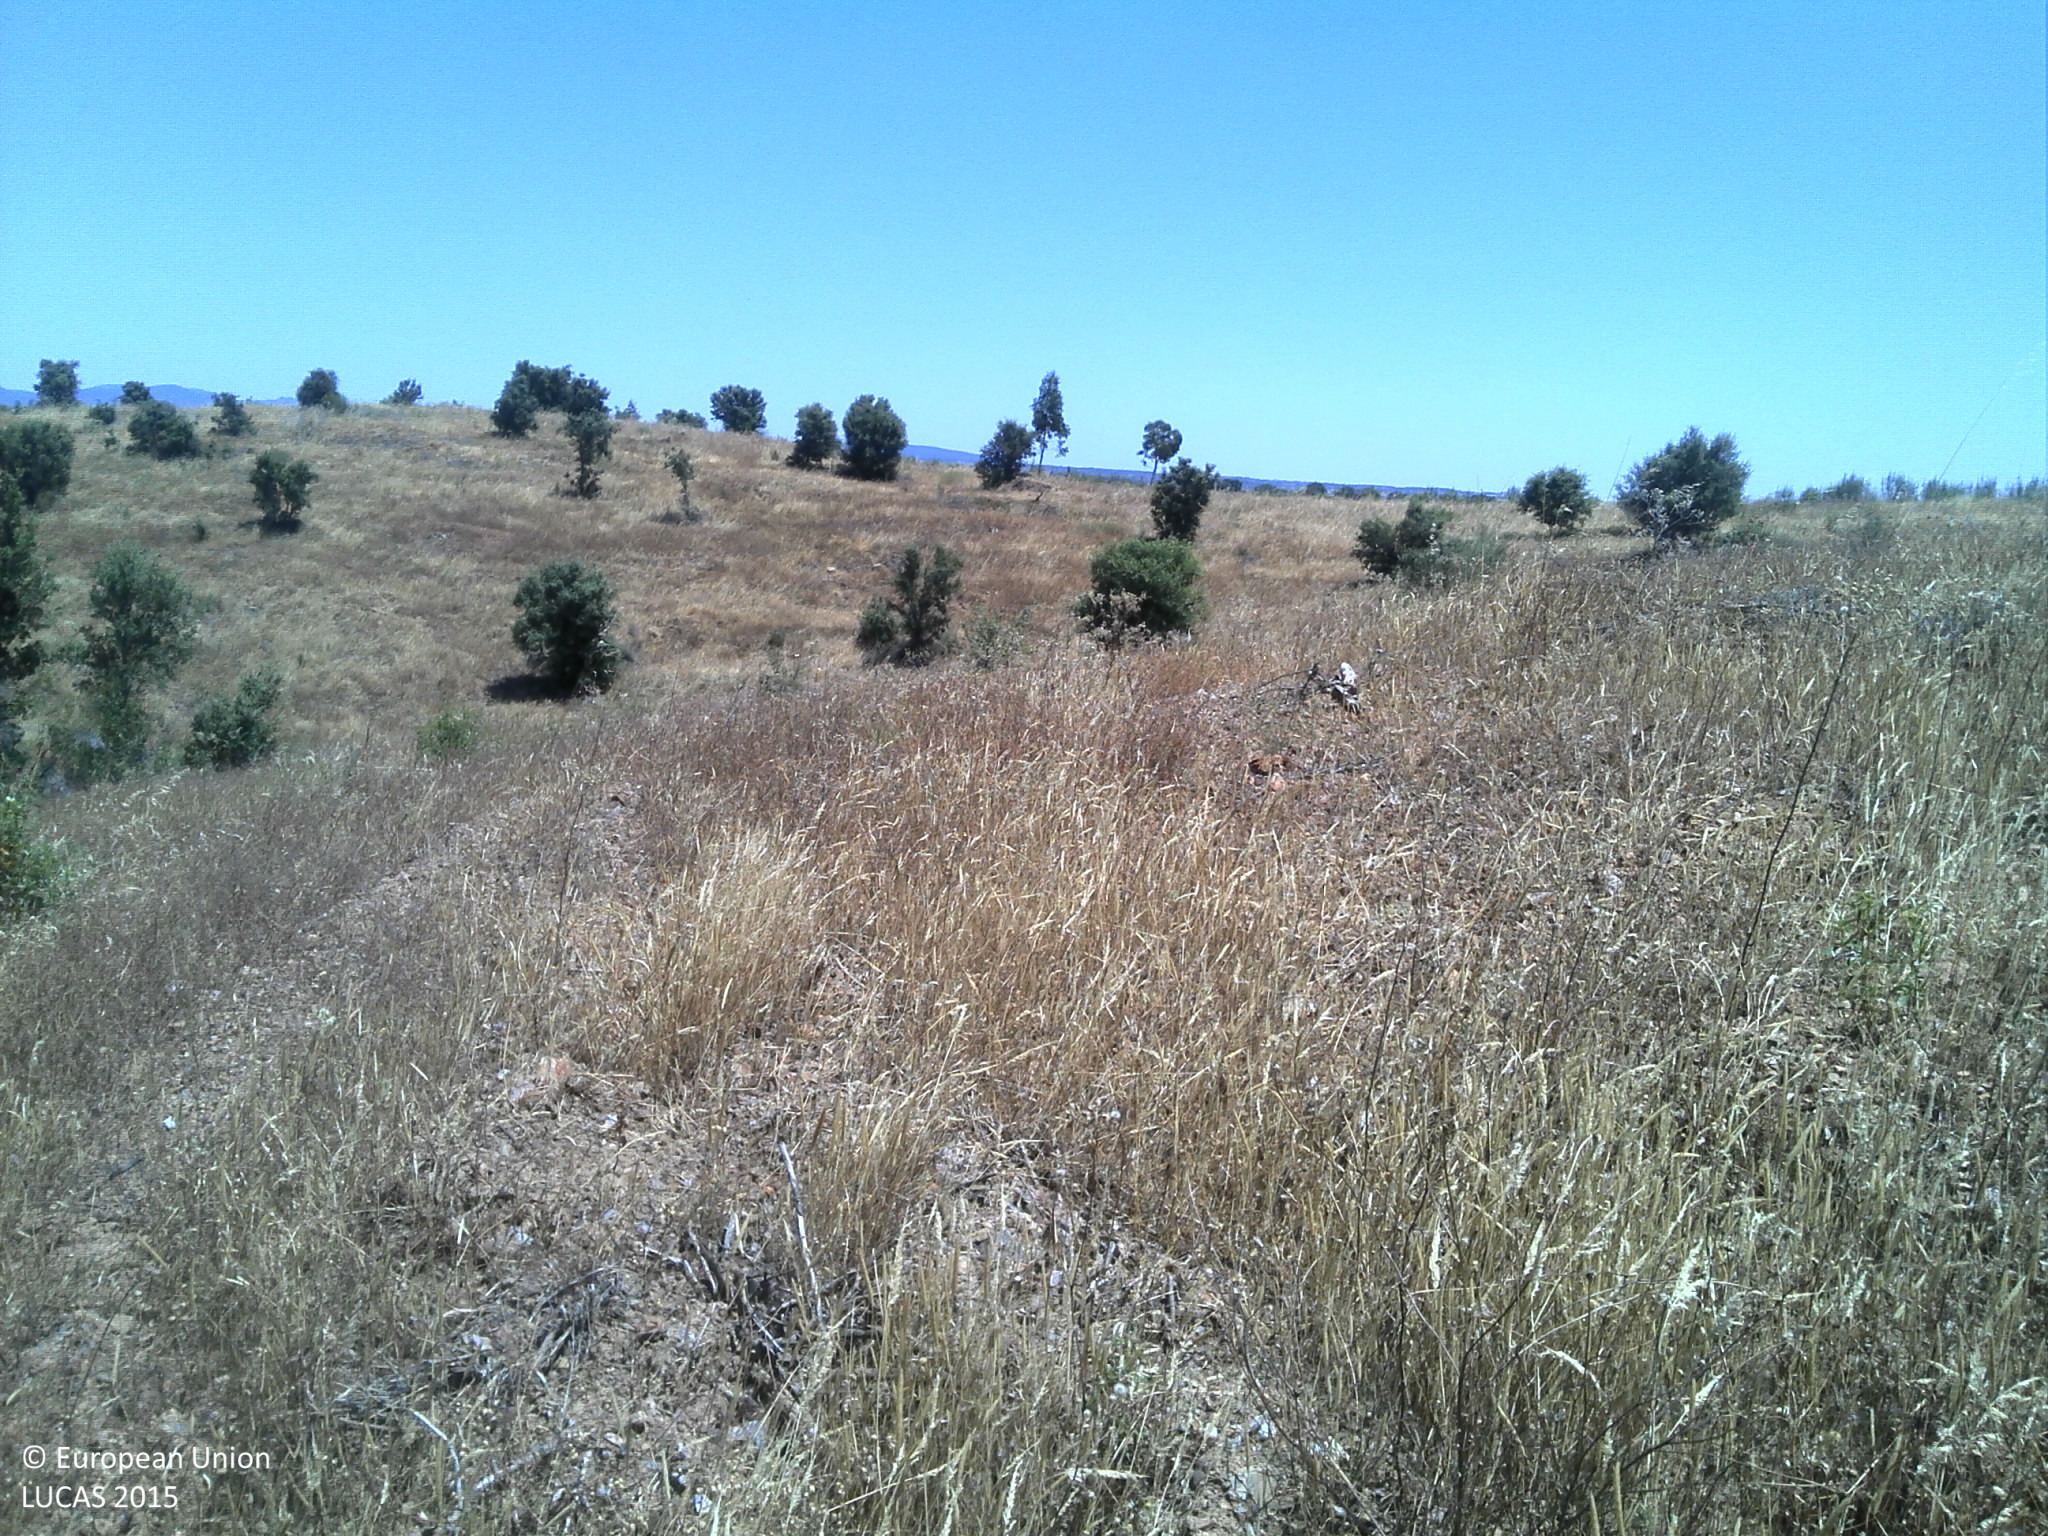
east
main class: Grassland
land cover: Grassland with sparse tree/shrub cover
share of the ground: 50 - 75 %
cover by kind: herbaceous plants 60 %, unconsolidated bare surface 20 %, broadleaved forest trees 5 %, shrubs 5 %
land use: Agriculture (excluding fallow land and kitchen gardens)
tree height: > 5 m
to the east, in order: Grassland with sparse tree/shrub cover; Tracks; Grassland with sparse tree/shrub cover
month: June
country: PT
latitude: 39.9848
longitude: -7.2282
